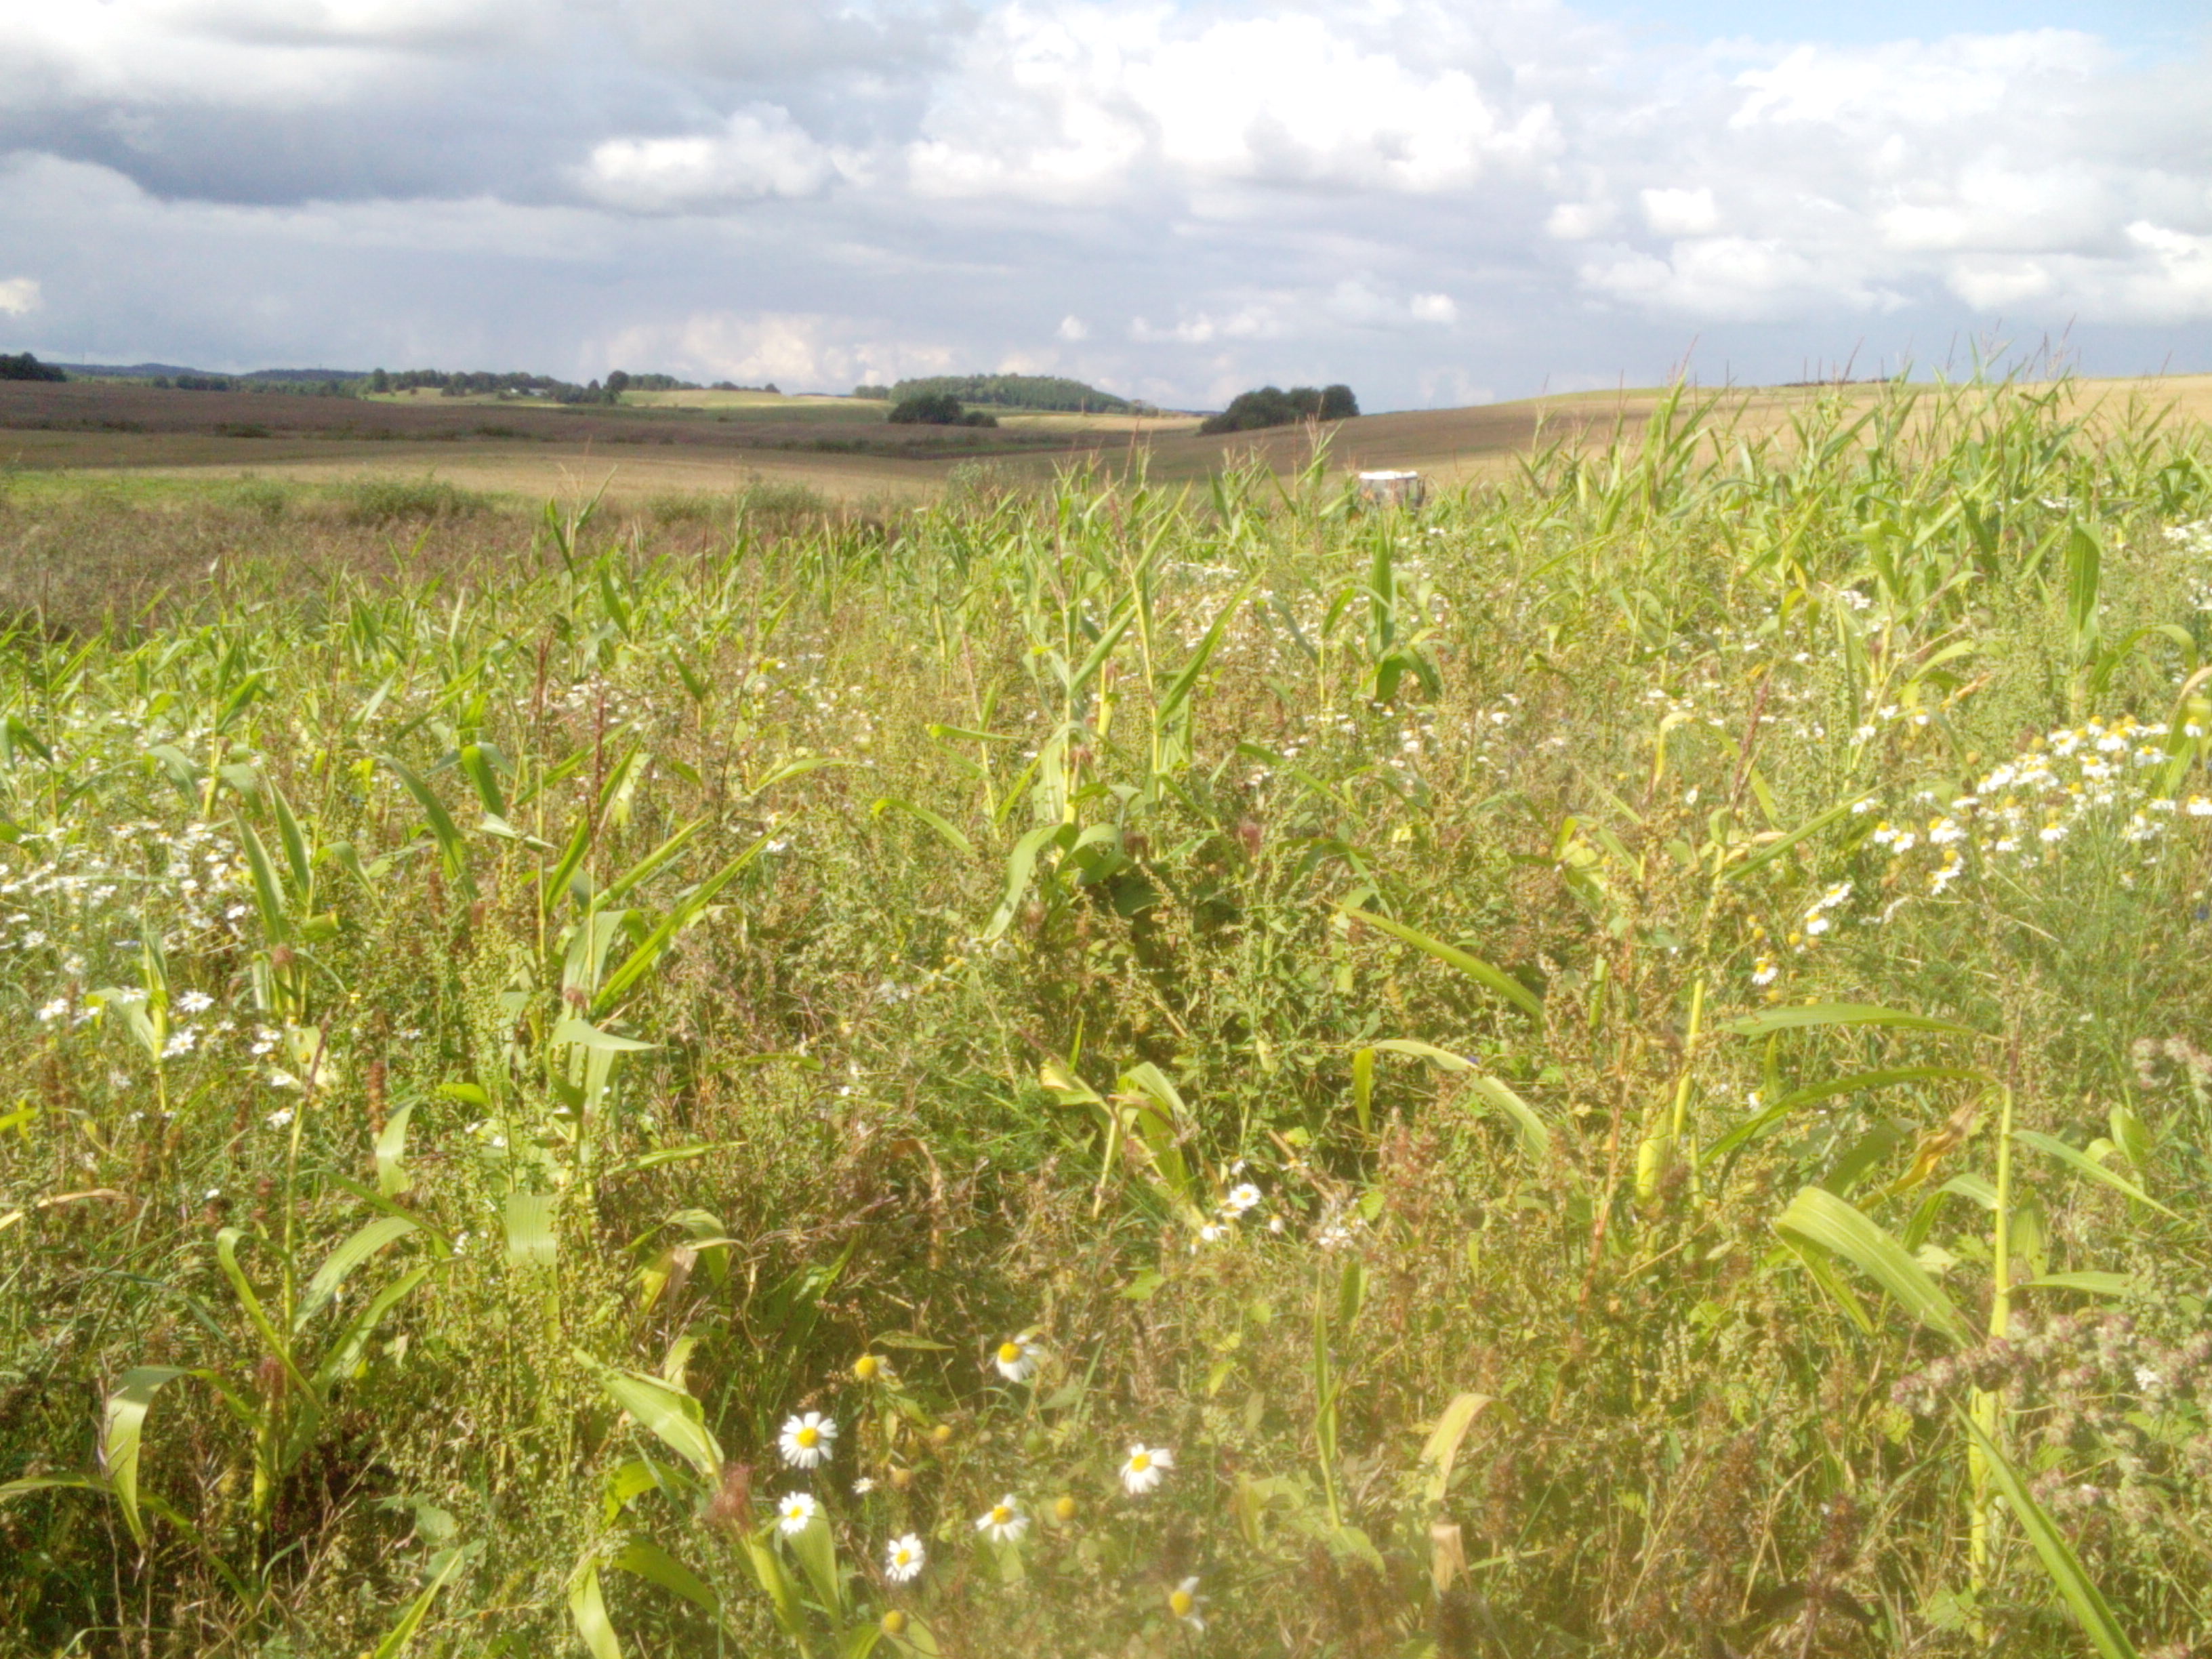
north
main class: Cropland
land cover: Maize
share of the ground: > 75 %
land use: Agriculture (excluding fallow land and kitchen gardens)
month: September
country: LT
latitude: 55.7937
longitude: 22.4846
